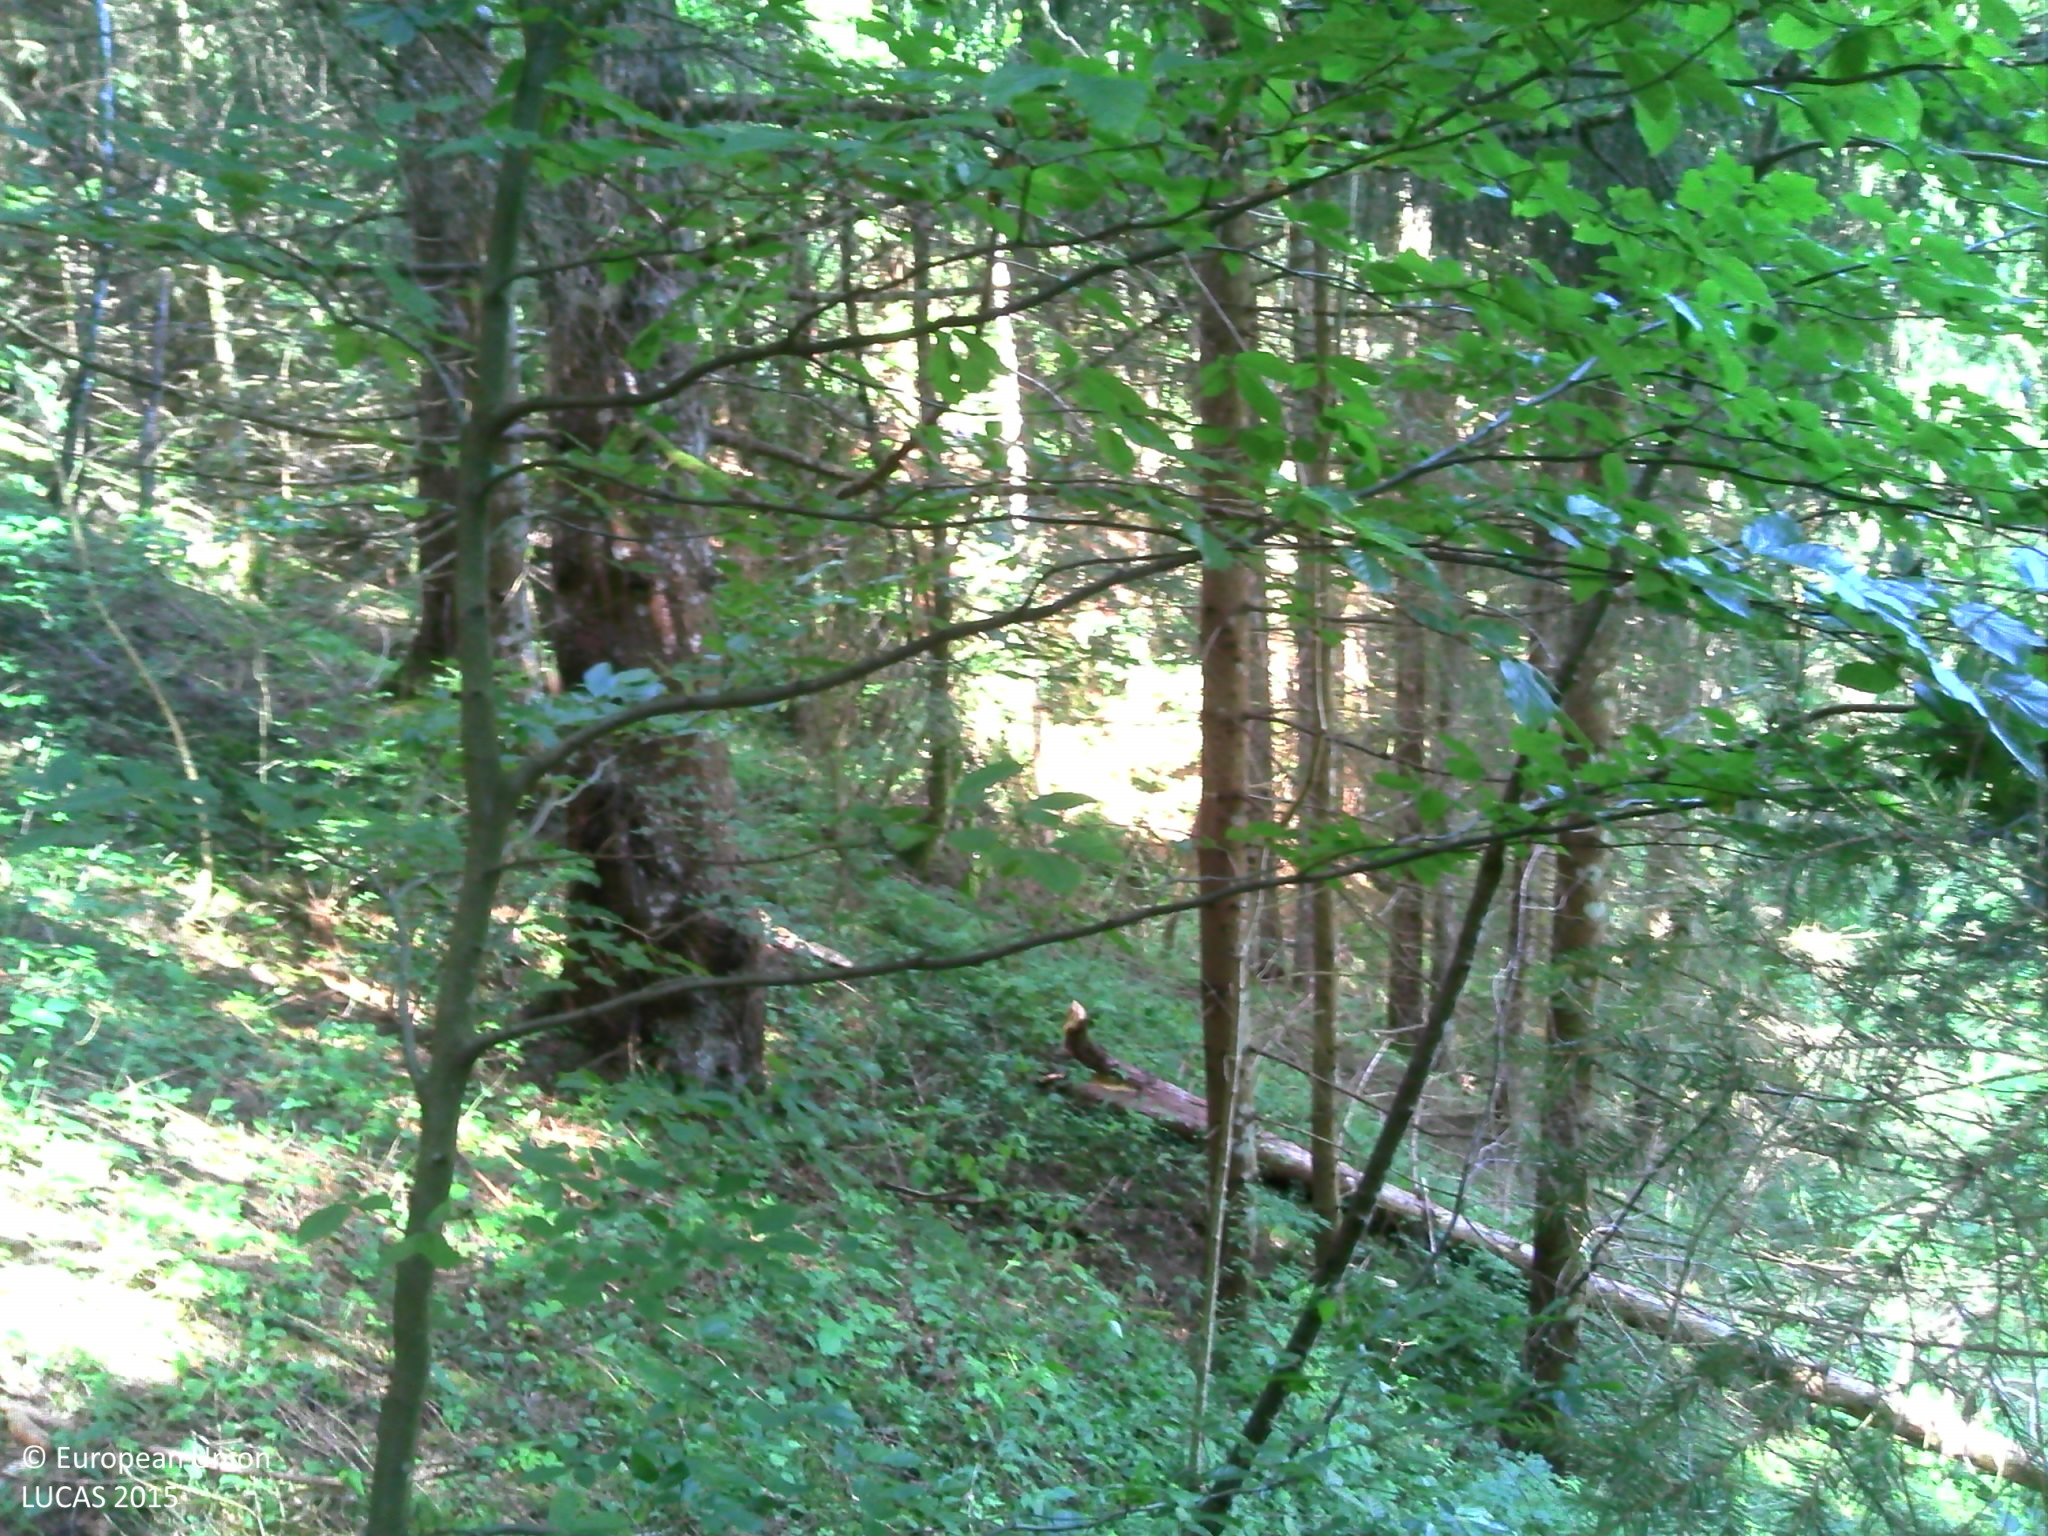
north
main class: Woodland
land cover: Spruce dominated coniferous woodland
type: alpine coniferous forest
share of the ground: > 75 %
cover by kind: coniferous forest trees 70 %, broadleaved forest trees 15 %, herbaceous plants 10 %, lichens and mosses 5 %
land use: Forestry
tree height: > 5 m
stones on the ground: < 10 %
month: July
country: FR
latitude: 46.1667
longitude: 6.4678
